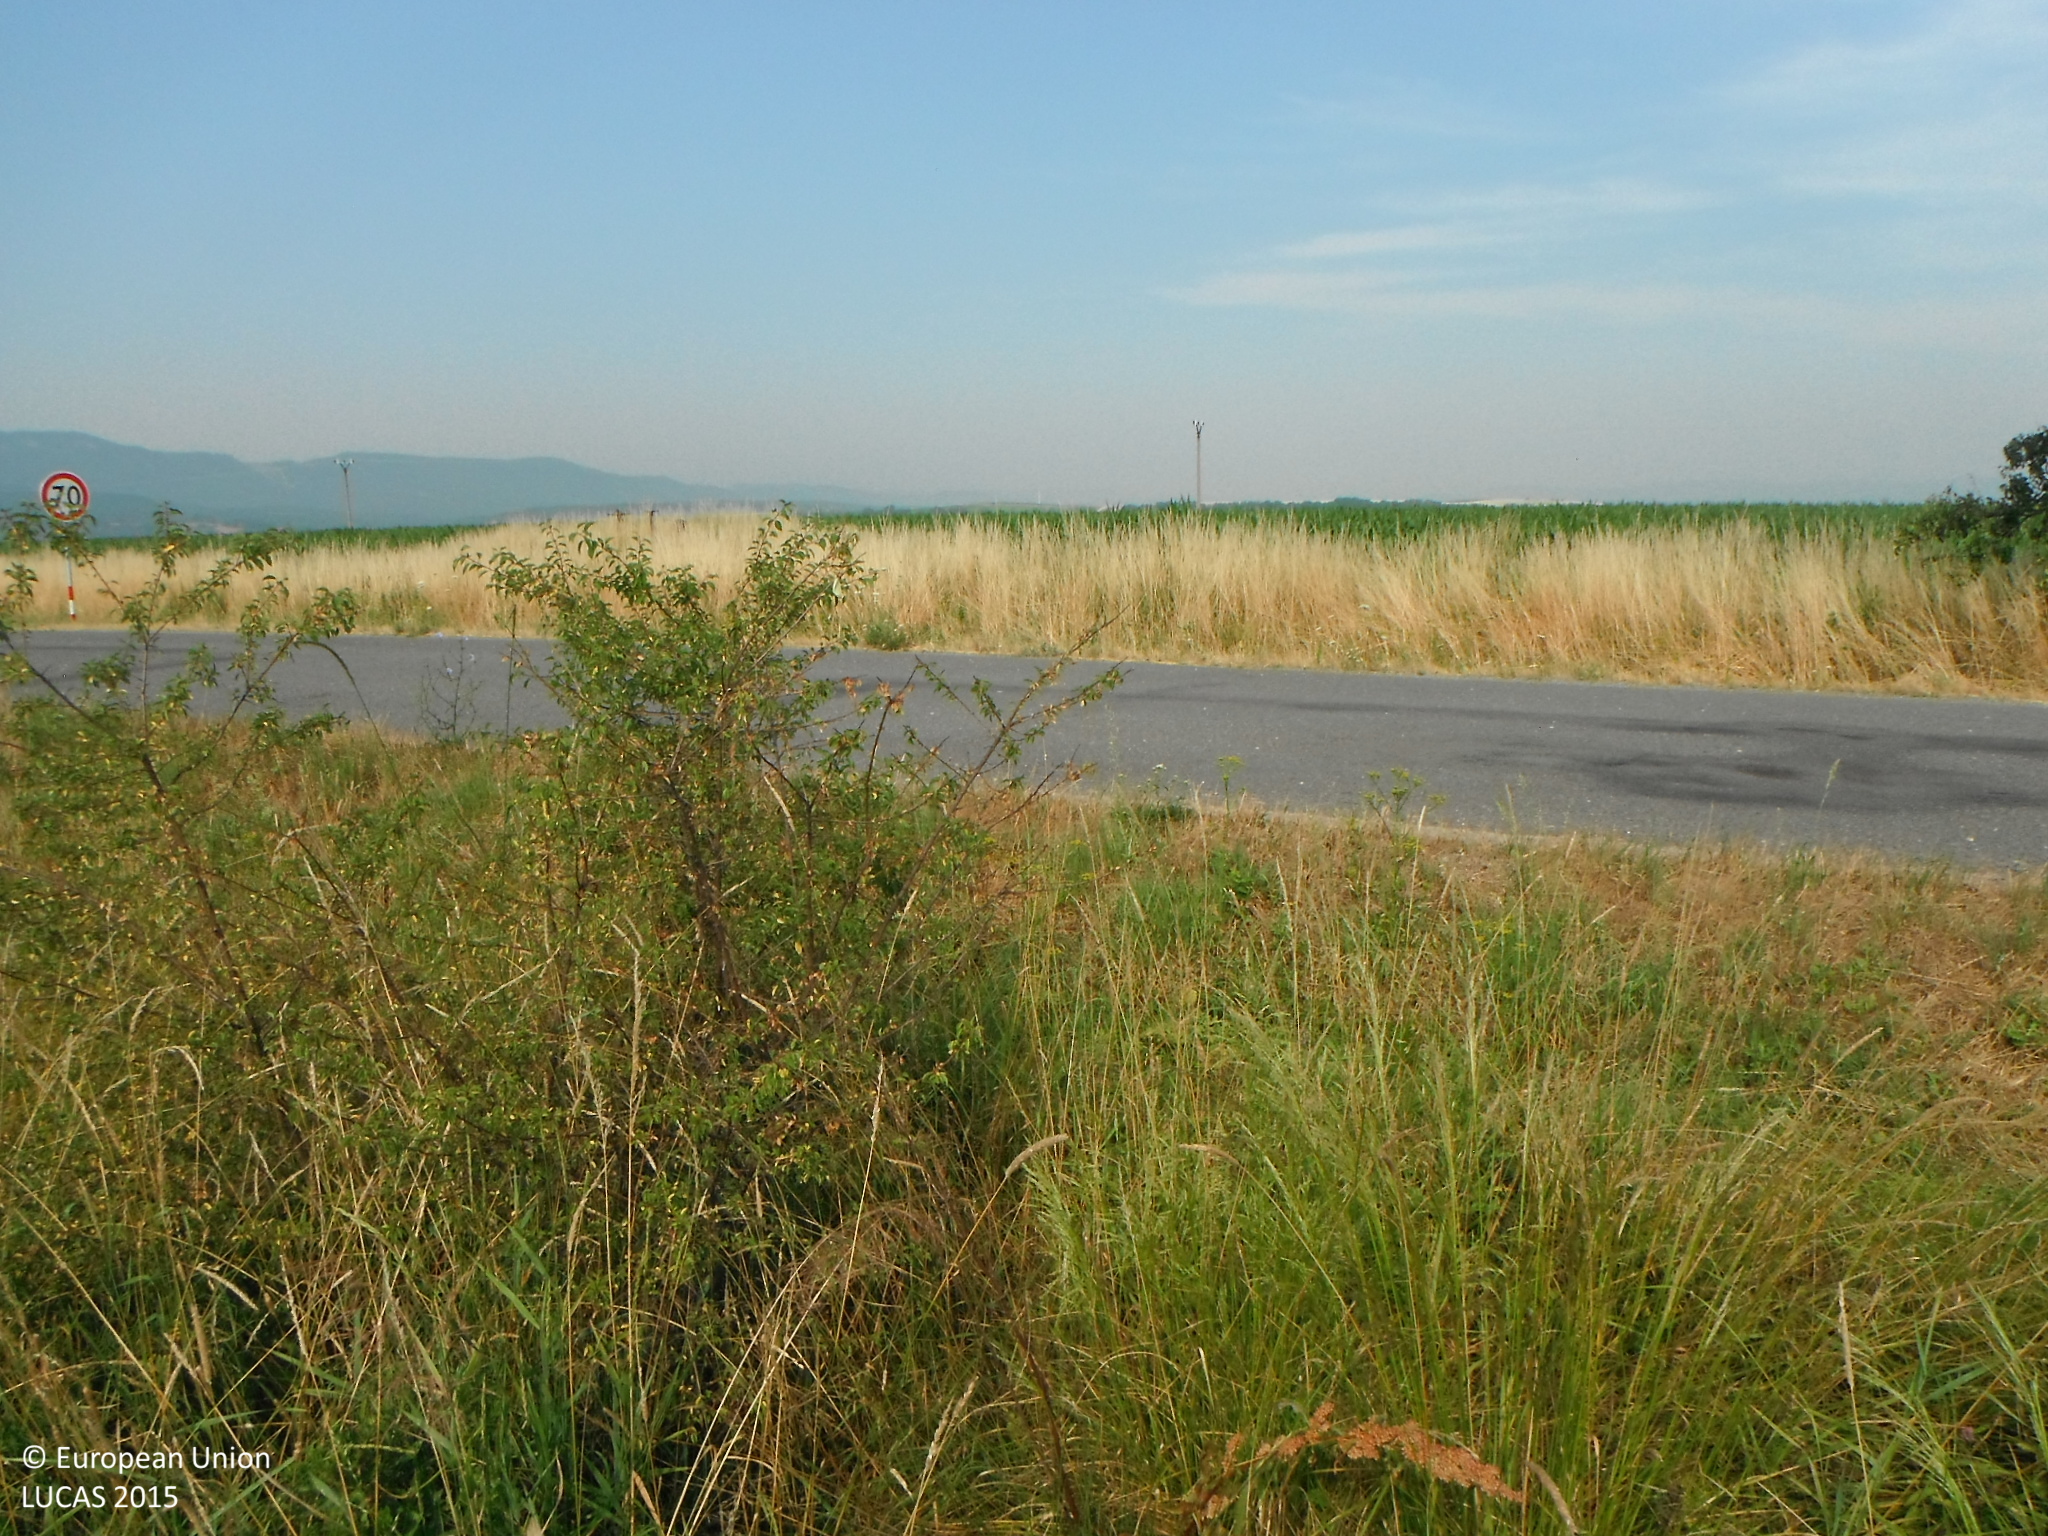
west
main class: Cropland
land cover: Maize
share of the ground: > 75 %
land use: Agriculture (excluding fallow land and kitchen gardens)
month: July
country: SK
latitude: 48.5739
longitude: 19.2801
